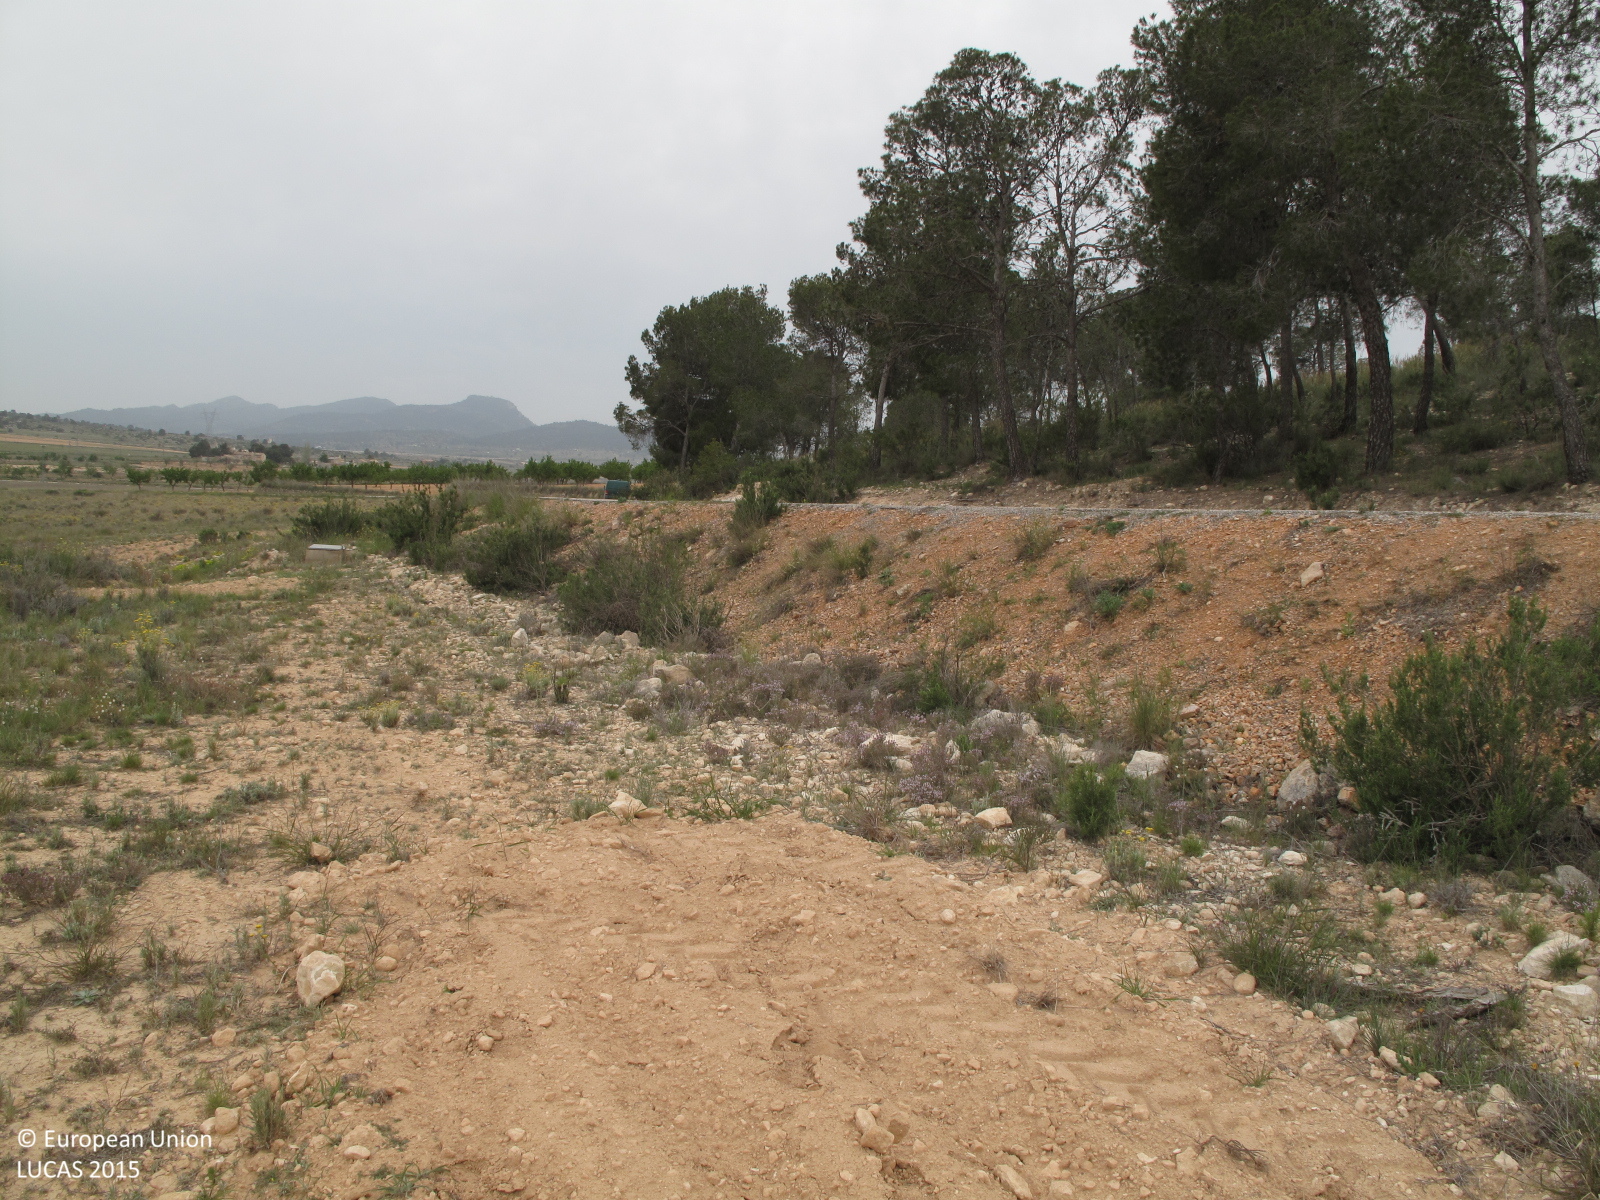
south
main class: Grassland
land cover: Spontaneously vegetated surfaces
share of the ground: 25 - 50 %
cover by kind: consolidated bare surface 55 %, herbaceous plants 45 %
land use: Fallow land
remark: Fire break
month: April
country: ES
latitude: 38.4703
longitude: -0.9116
